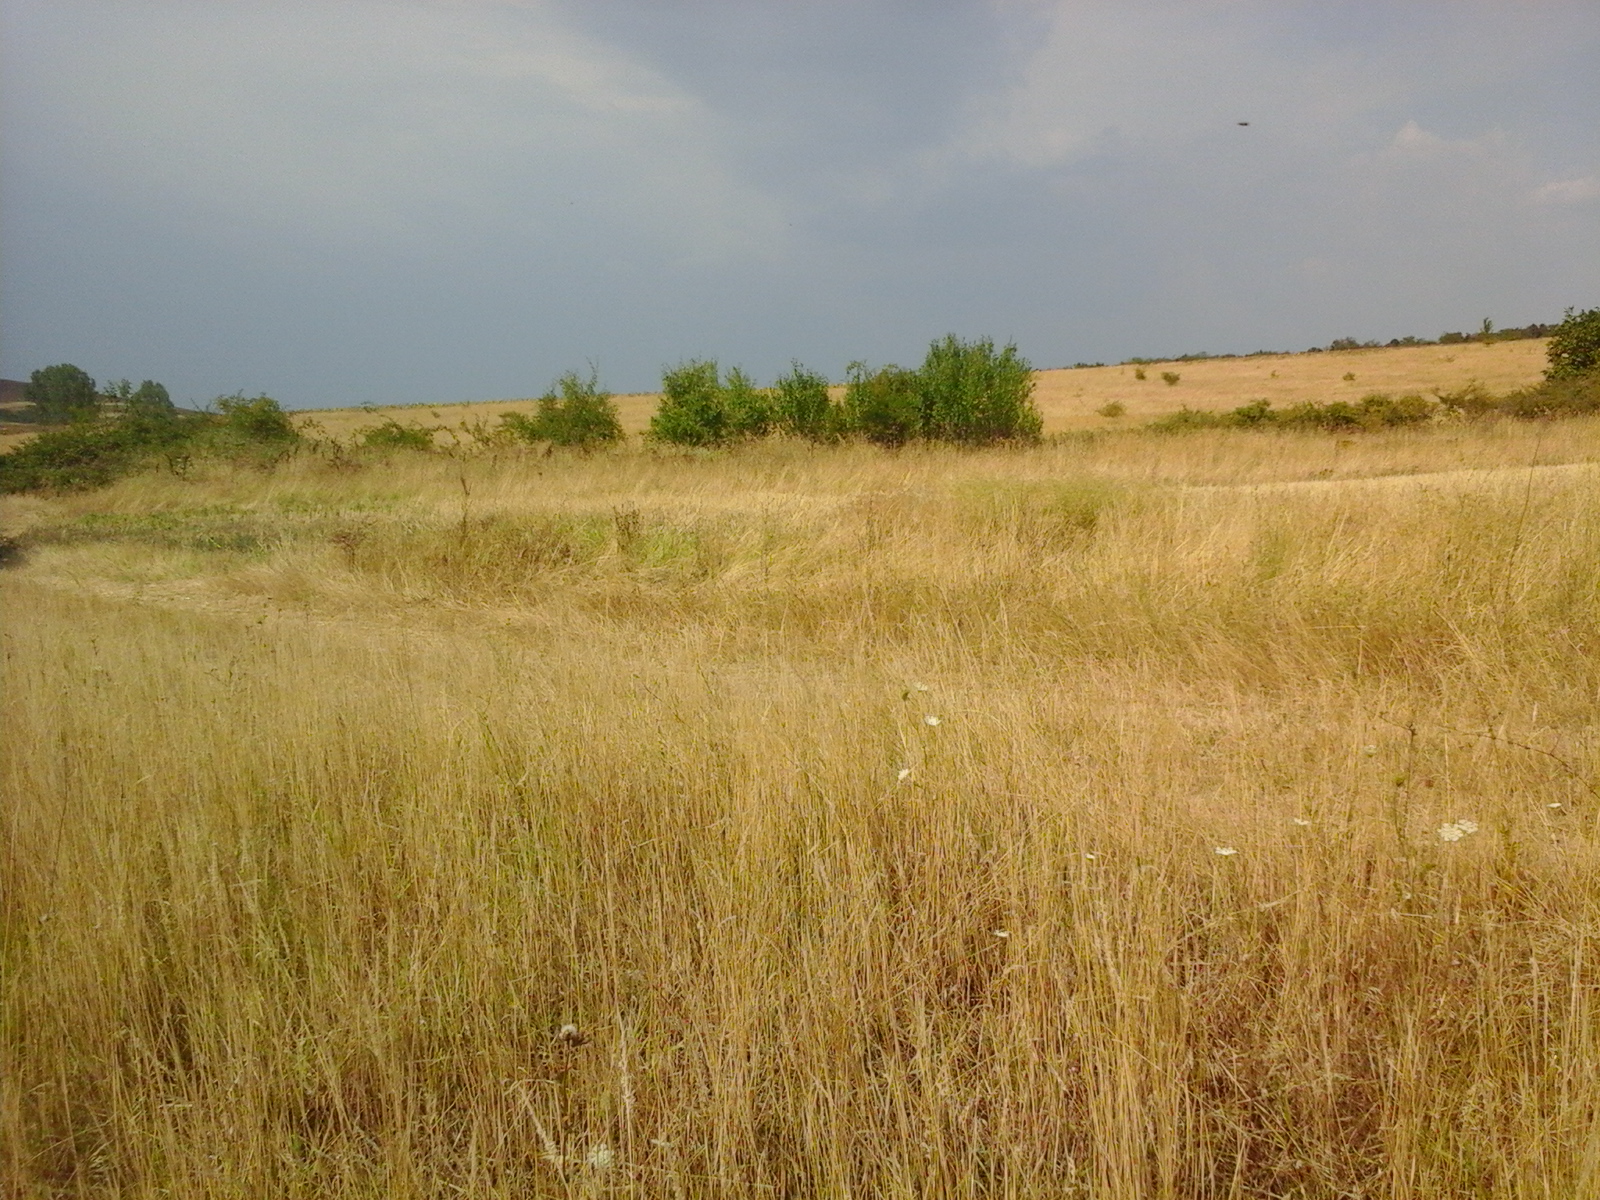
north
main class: Grassland
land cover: Grassland without tree/shrub cover
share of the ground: > 75 %
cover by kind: herbaceous plants 100 %
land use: Agriculture (excluding fallow land and kitchen gardens)
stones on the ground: < 10 %
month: August
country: RO
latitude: 44.4754
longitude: 22.7261
